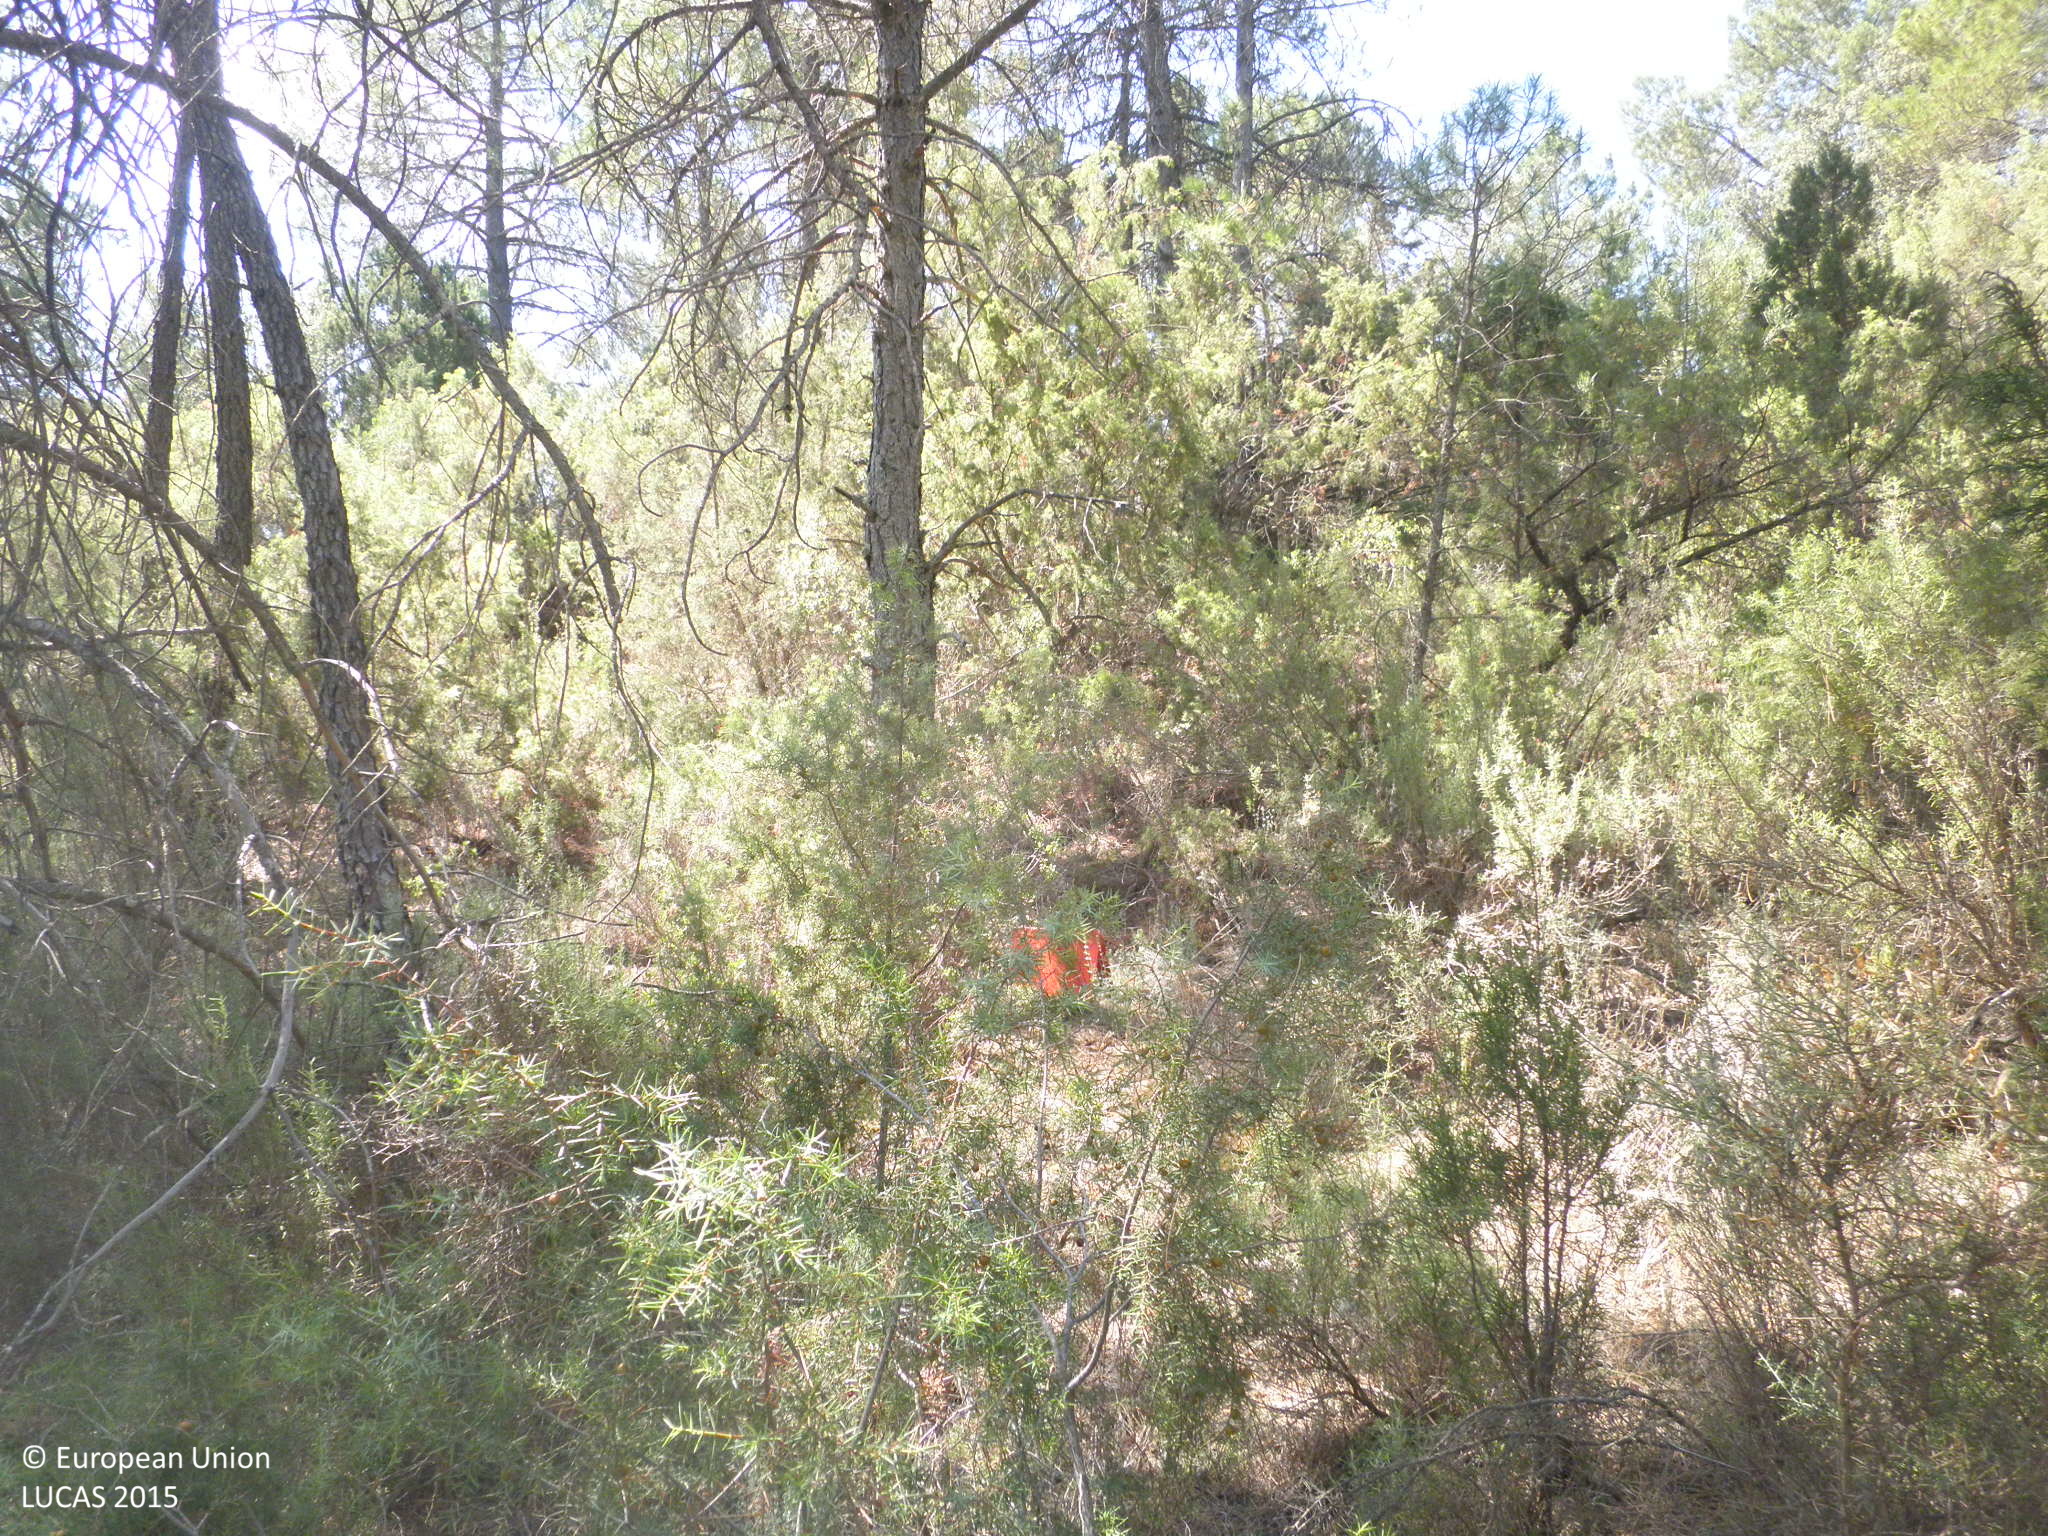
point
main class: Woodland
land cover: Pine dominated coniferous woodland
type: coniferous forest of the mediterranean region
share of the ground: 50 - 75 %
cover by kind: coniferous forest trees 60 %, unconsolidated bare surface 20 %, shrubs 15 %, herbaceous plants 5 %
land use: Semi-natural and natural areas not in use
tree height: > 5 m
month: July
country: ES
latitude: 39.6866
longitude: -1.7498
